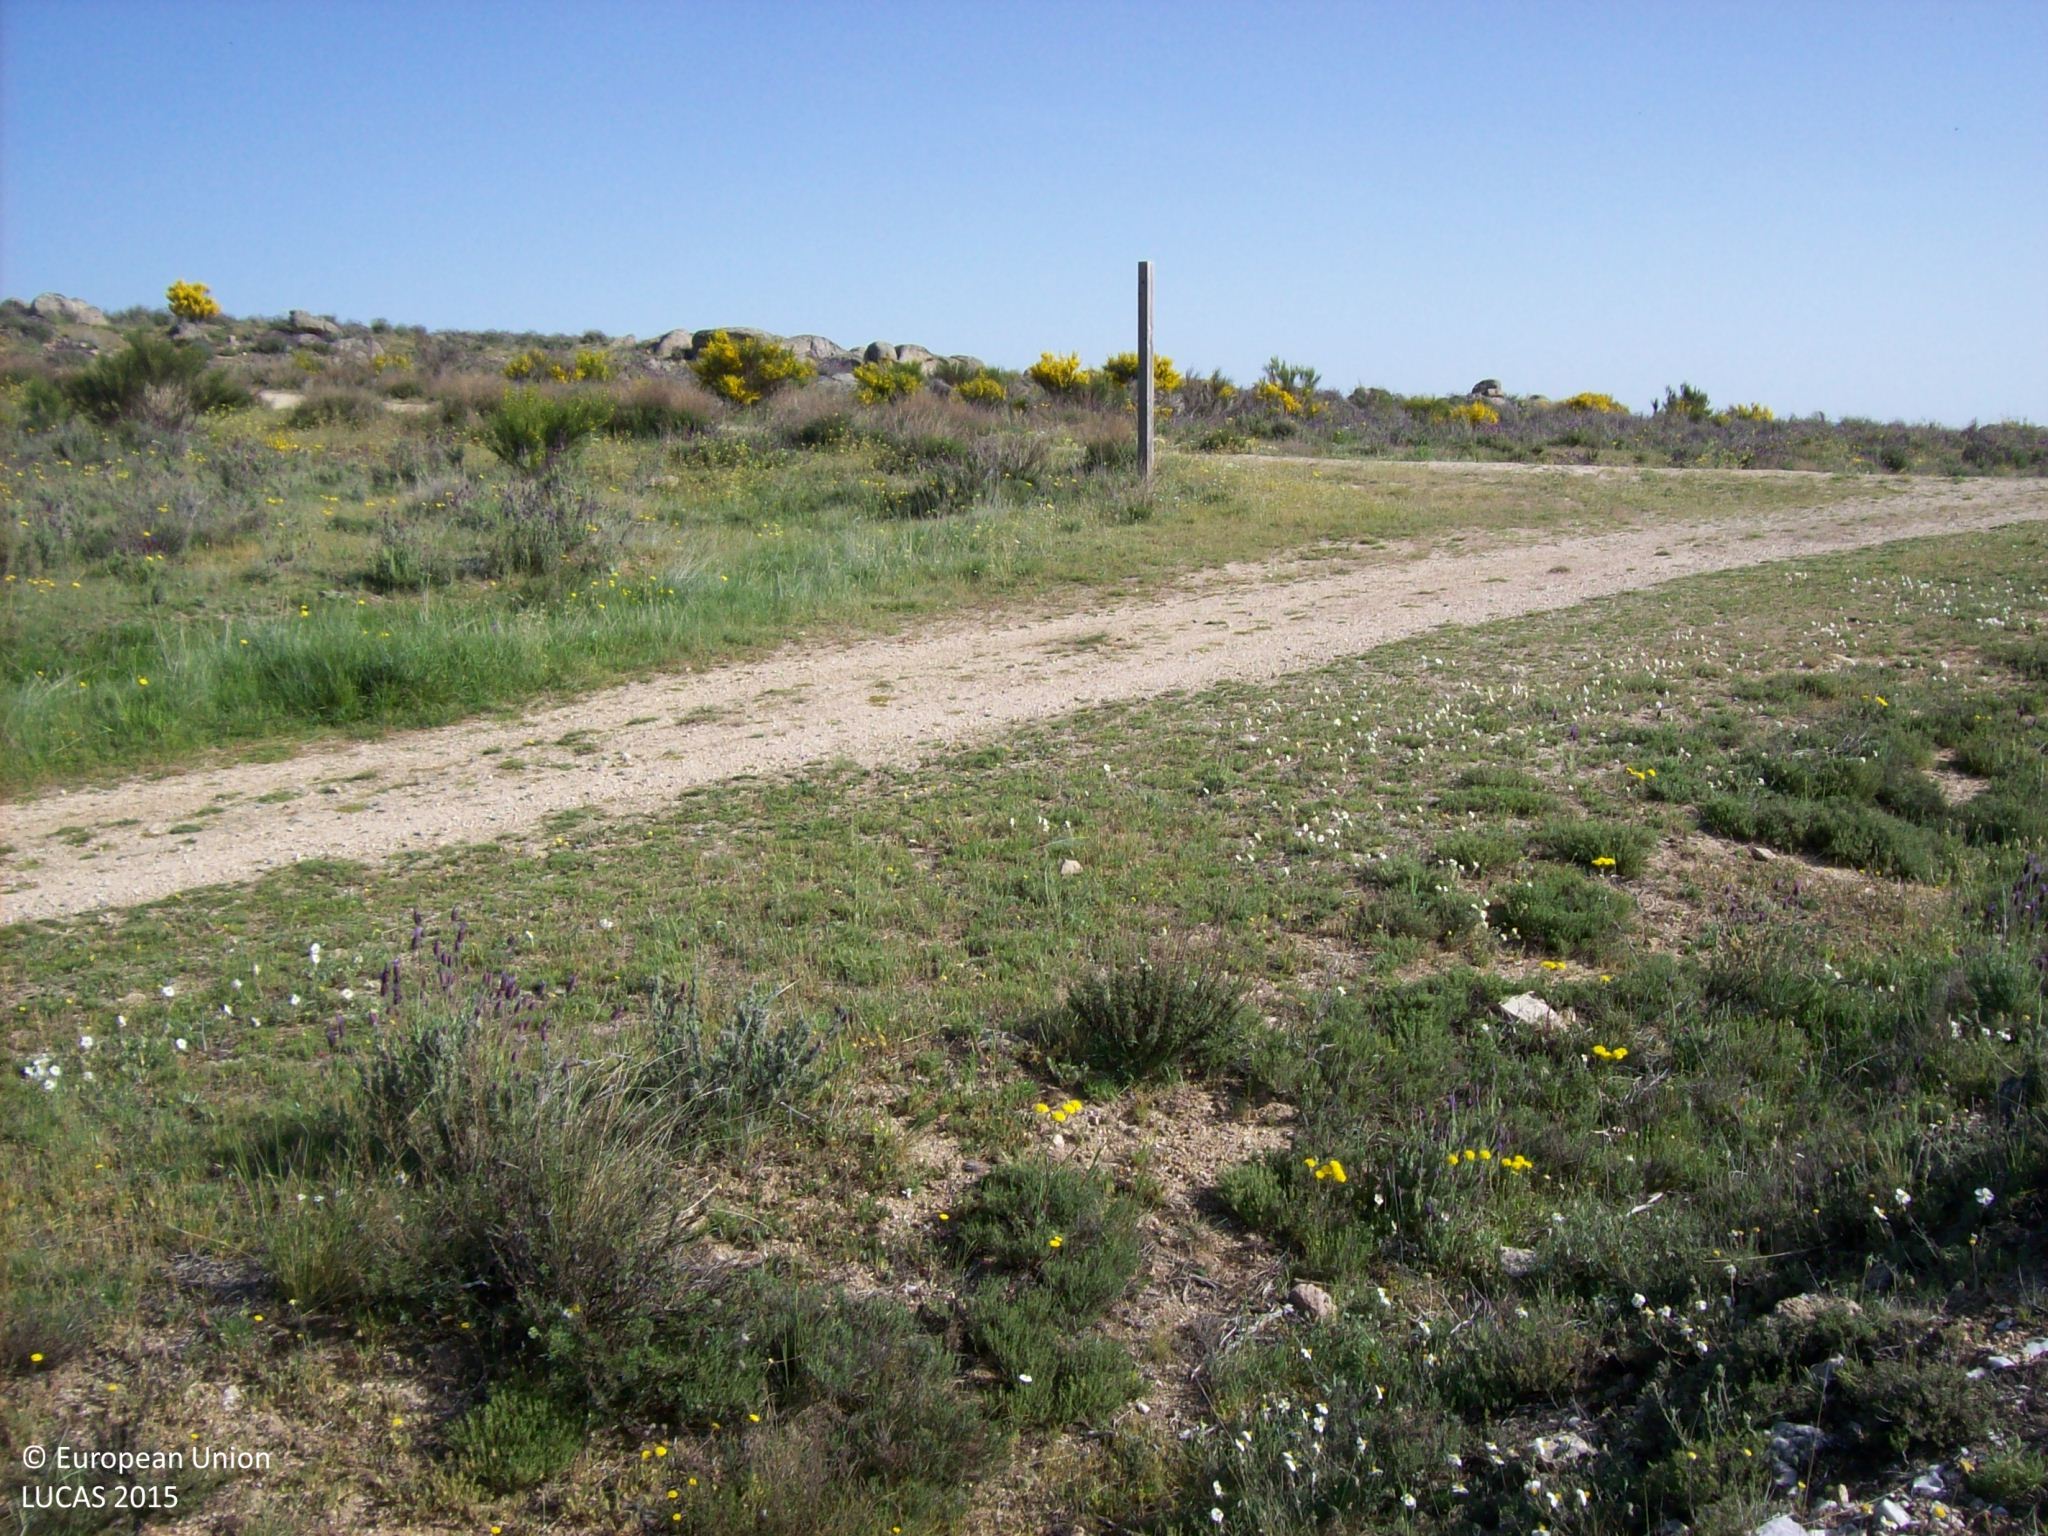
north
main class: Shrubland
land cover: Shrubland without tree cover
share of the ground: 50 - 75 %
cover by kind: shrubs 60 %, herbaceous plants 20 %, consolidated bare surface 5 %, unconsolidated bare surface 5 %
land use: Semi-natural and natural areas not in use
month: May
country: ES
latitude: 40.5470
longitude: -4.8280
